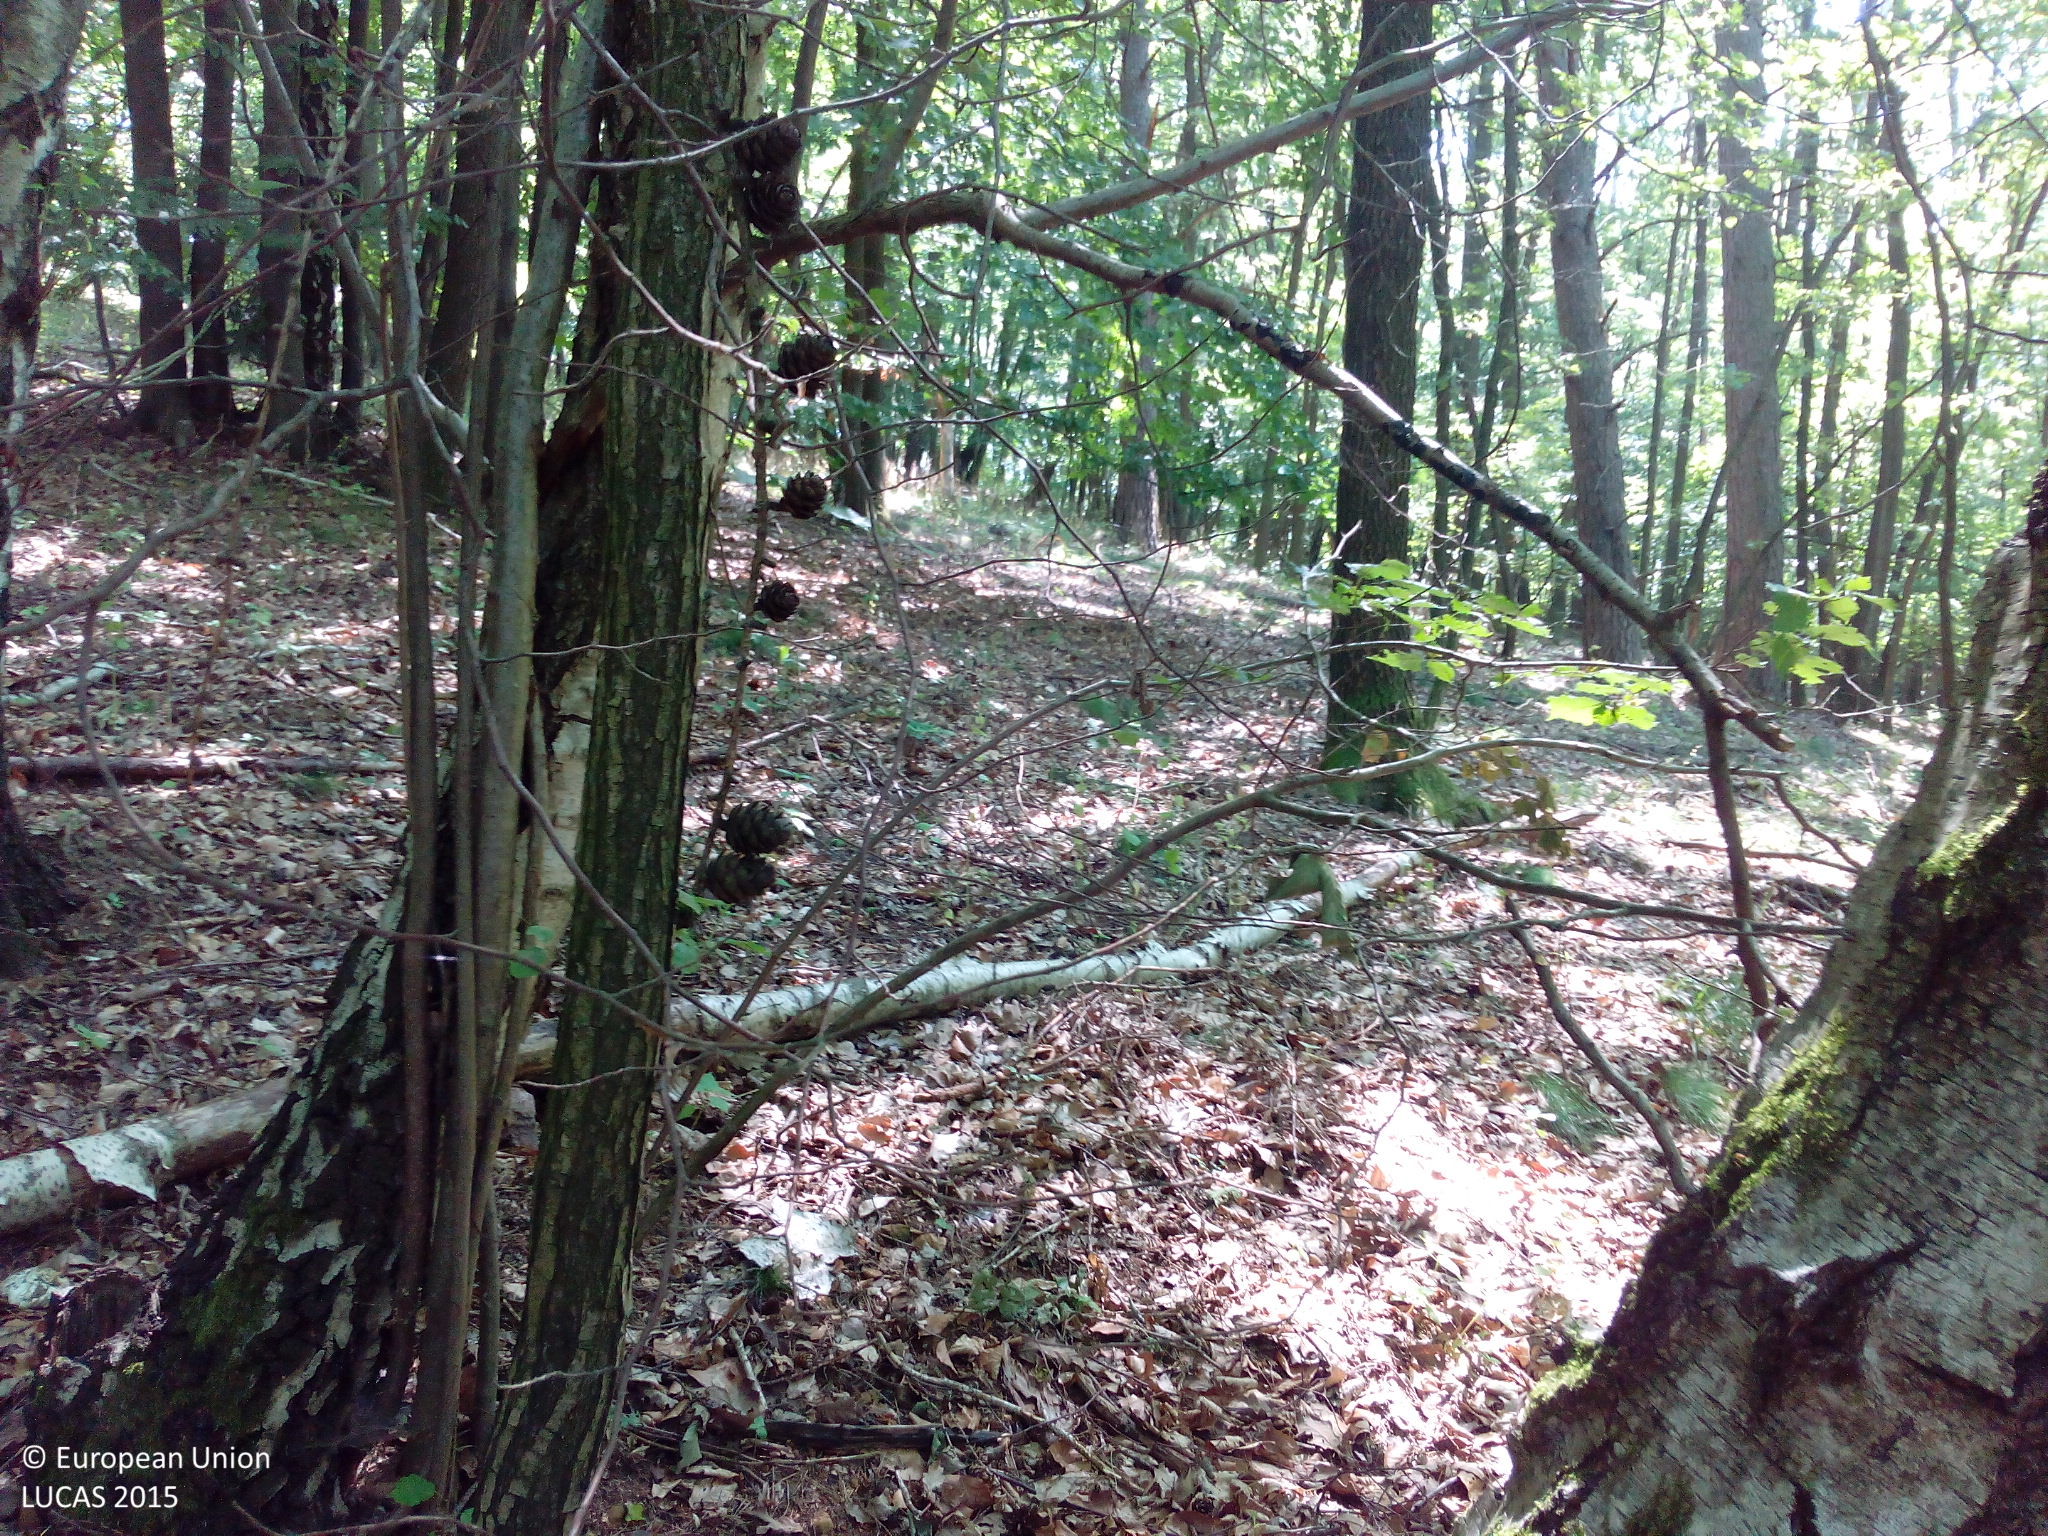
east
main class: Woodland
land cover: Pine dominated mixed woodland
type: hemiboreal forest and nemoral coniferous forest and mixed broadleaved-coniferous forest
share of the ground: > 75 %
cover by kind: broadleaved forest trees 60 %, coniferous forest trees 30 %, herbaceous plants 5 %, unconsolidated bare surface 5 %
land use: Forestry
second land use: Amenities, museums, leisure
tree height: > 5 m
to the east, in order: Pine dominated mixed woodland; Broadleaved woodland; Tracks; Broadleaved woodland; Tracks; Broadleaved woodland; Artificial constructions in urban areas; Grass margins
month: July
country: DE
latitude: 49.8195
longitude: 11.0699
